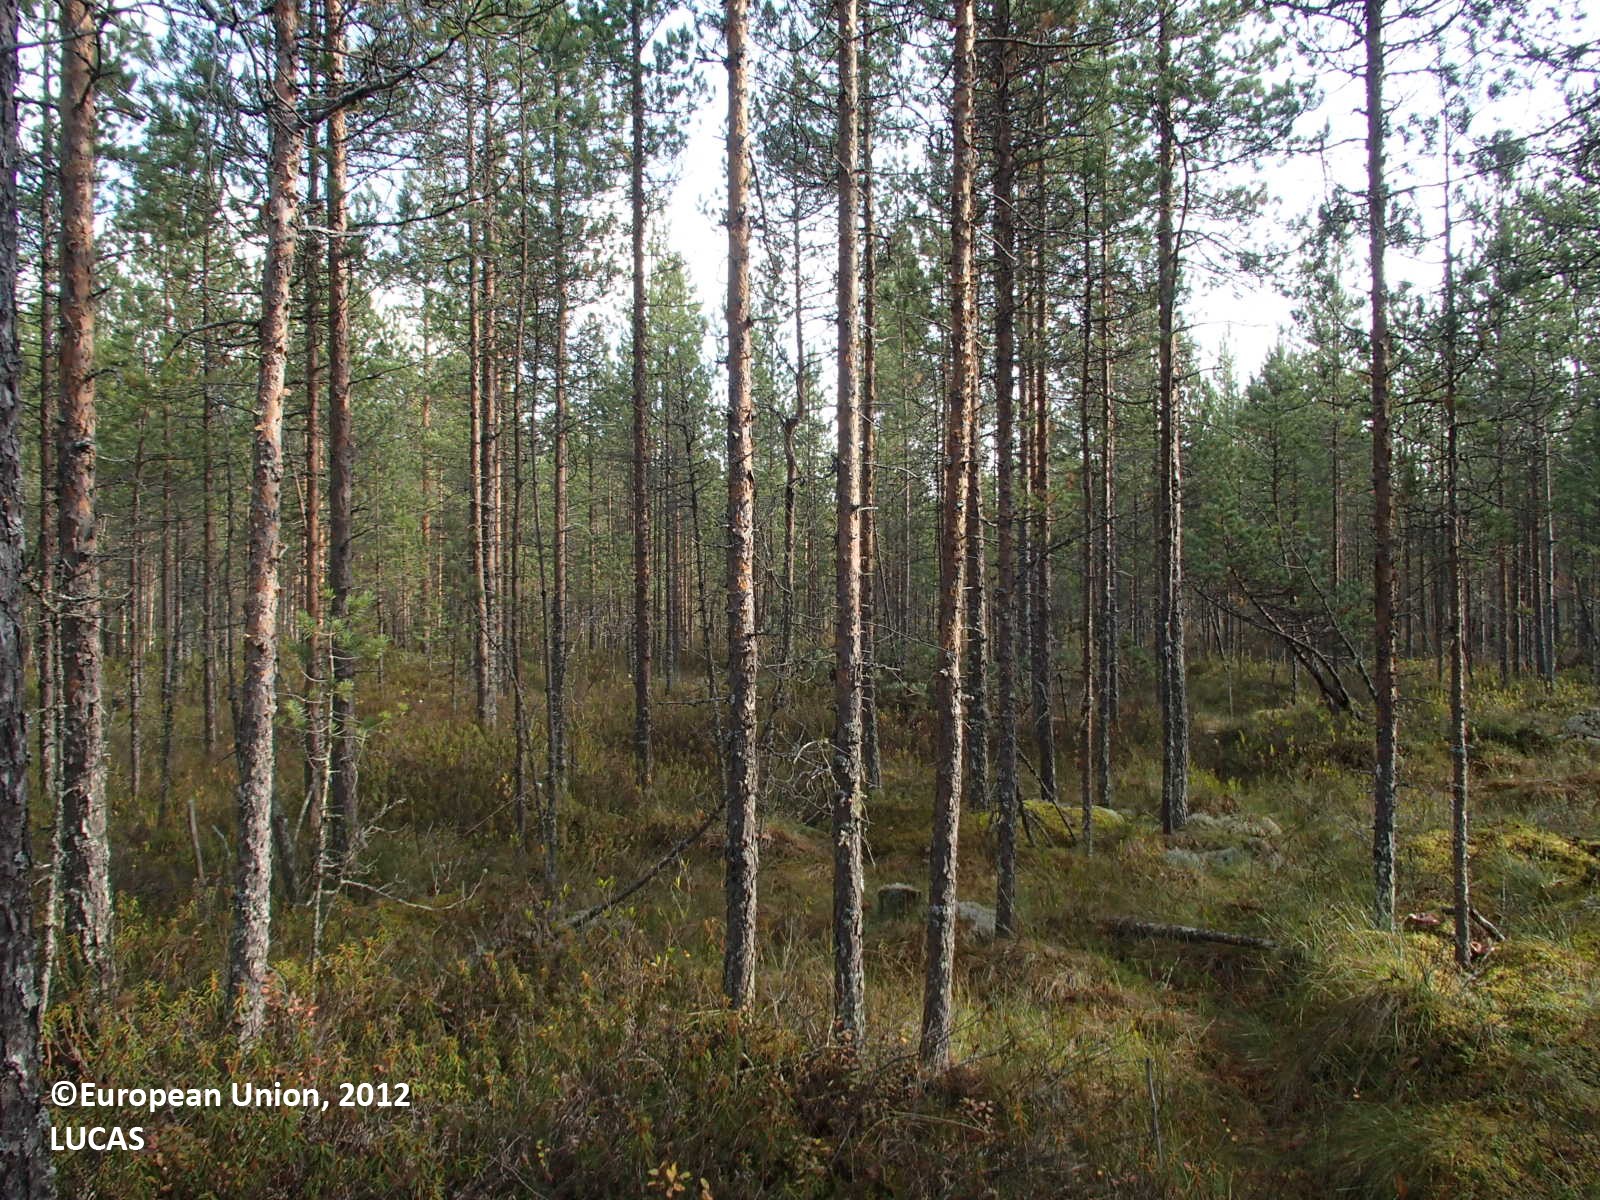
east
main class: Woodland
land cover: Pine dominated coniferous woodland
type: boreal forest
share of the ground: 50 - 75 %
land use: Forestry
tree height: > 5 m
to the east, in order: Pine dominated coniferous woodland; Ditches and canals; Pine dominated coniferous woodland; Ditches and canals; Pine dominated mixed woodland; Ditches and canals; Pine dominated mixed woodland
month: September
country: FI
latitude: 63.6220
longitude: 26.1129
